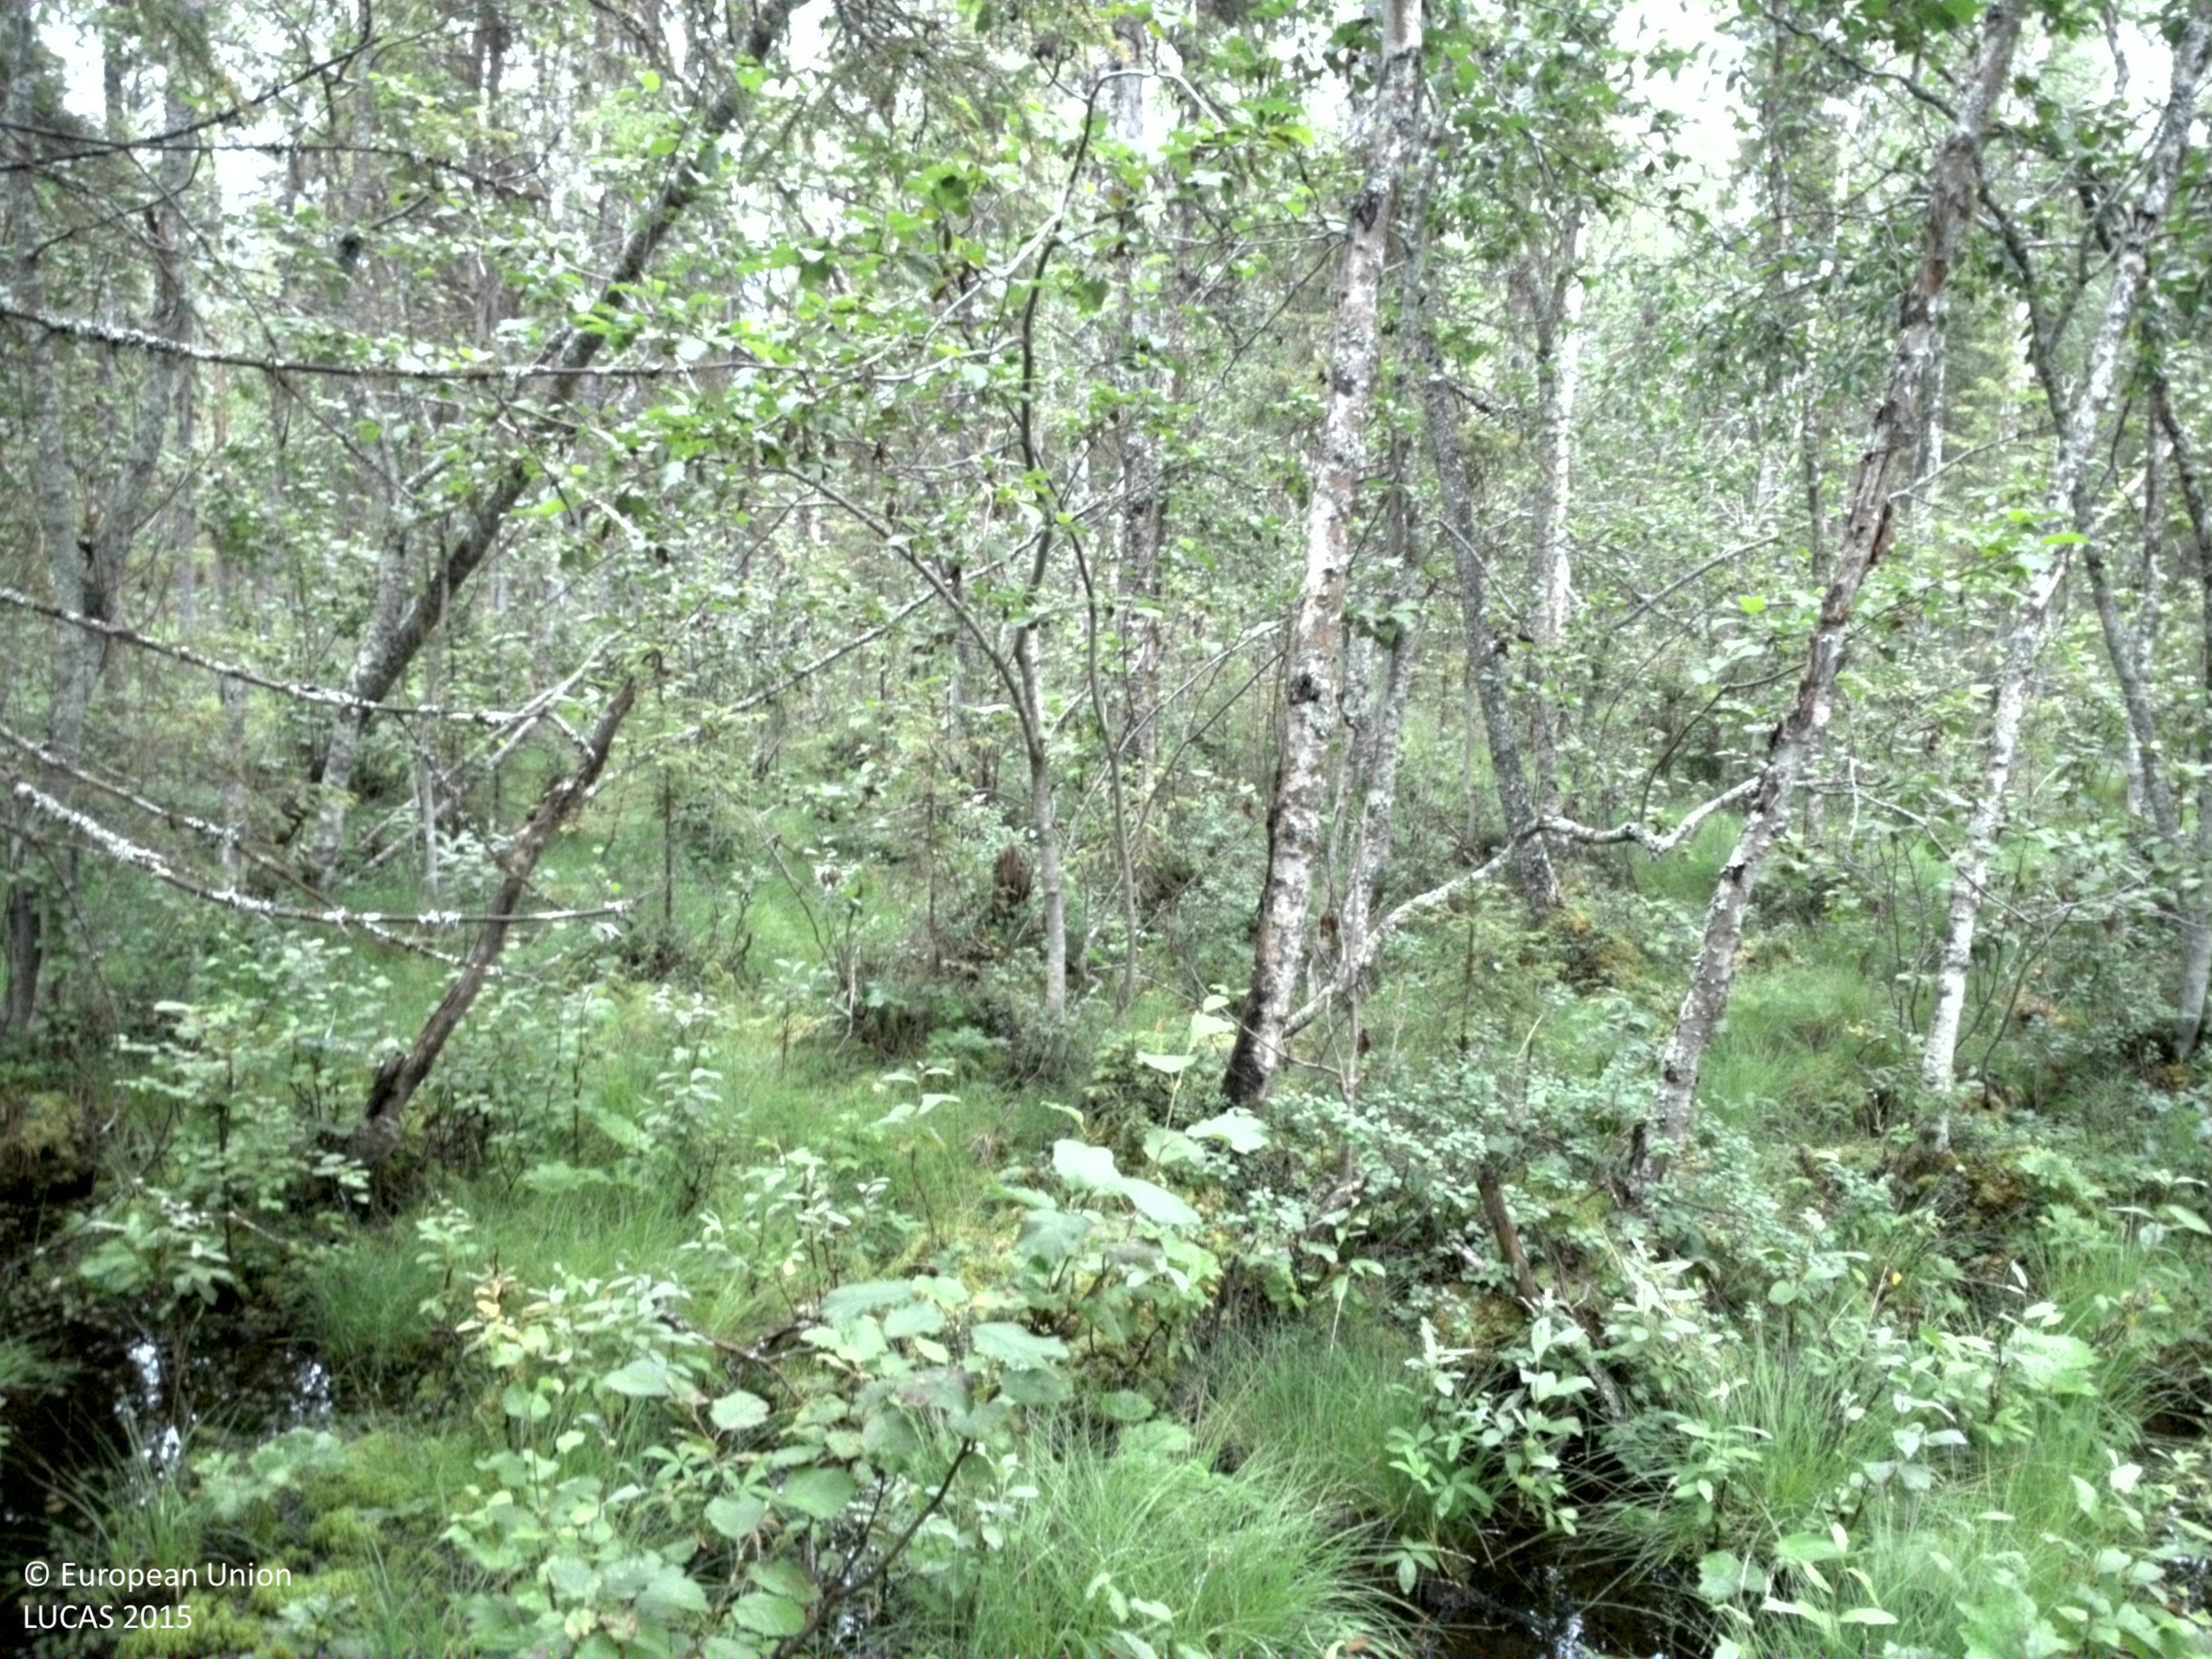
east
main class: Woodland
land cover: Broadleaved woodland
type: mire and swamp forests
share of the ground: 50 - 75 %
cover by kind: broadleaved forest trees 50 %, shrubs 30 %, coniferous forest trees 10 %
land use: Semi-natural and natural areas not in use
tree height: > 5 m
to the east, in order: Broadleaved woodland; Spruce dominated coniferous woodland; Pine dominated coniferous woodland; Paved roads, cycling and walking lanes; Groves; Pine dominated coniferous woodland
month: August
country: SE
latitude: 66.4948
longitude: 20.5395
